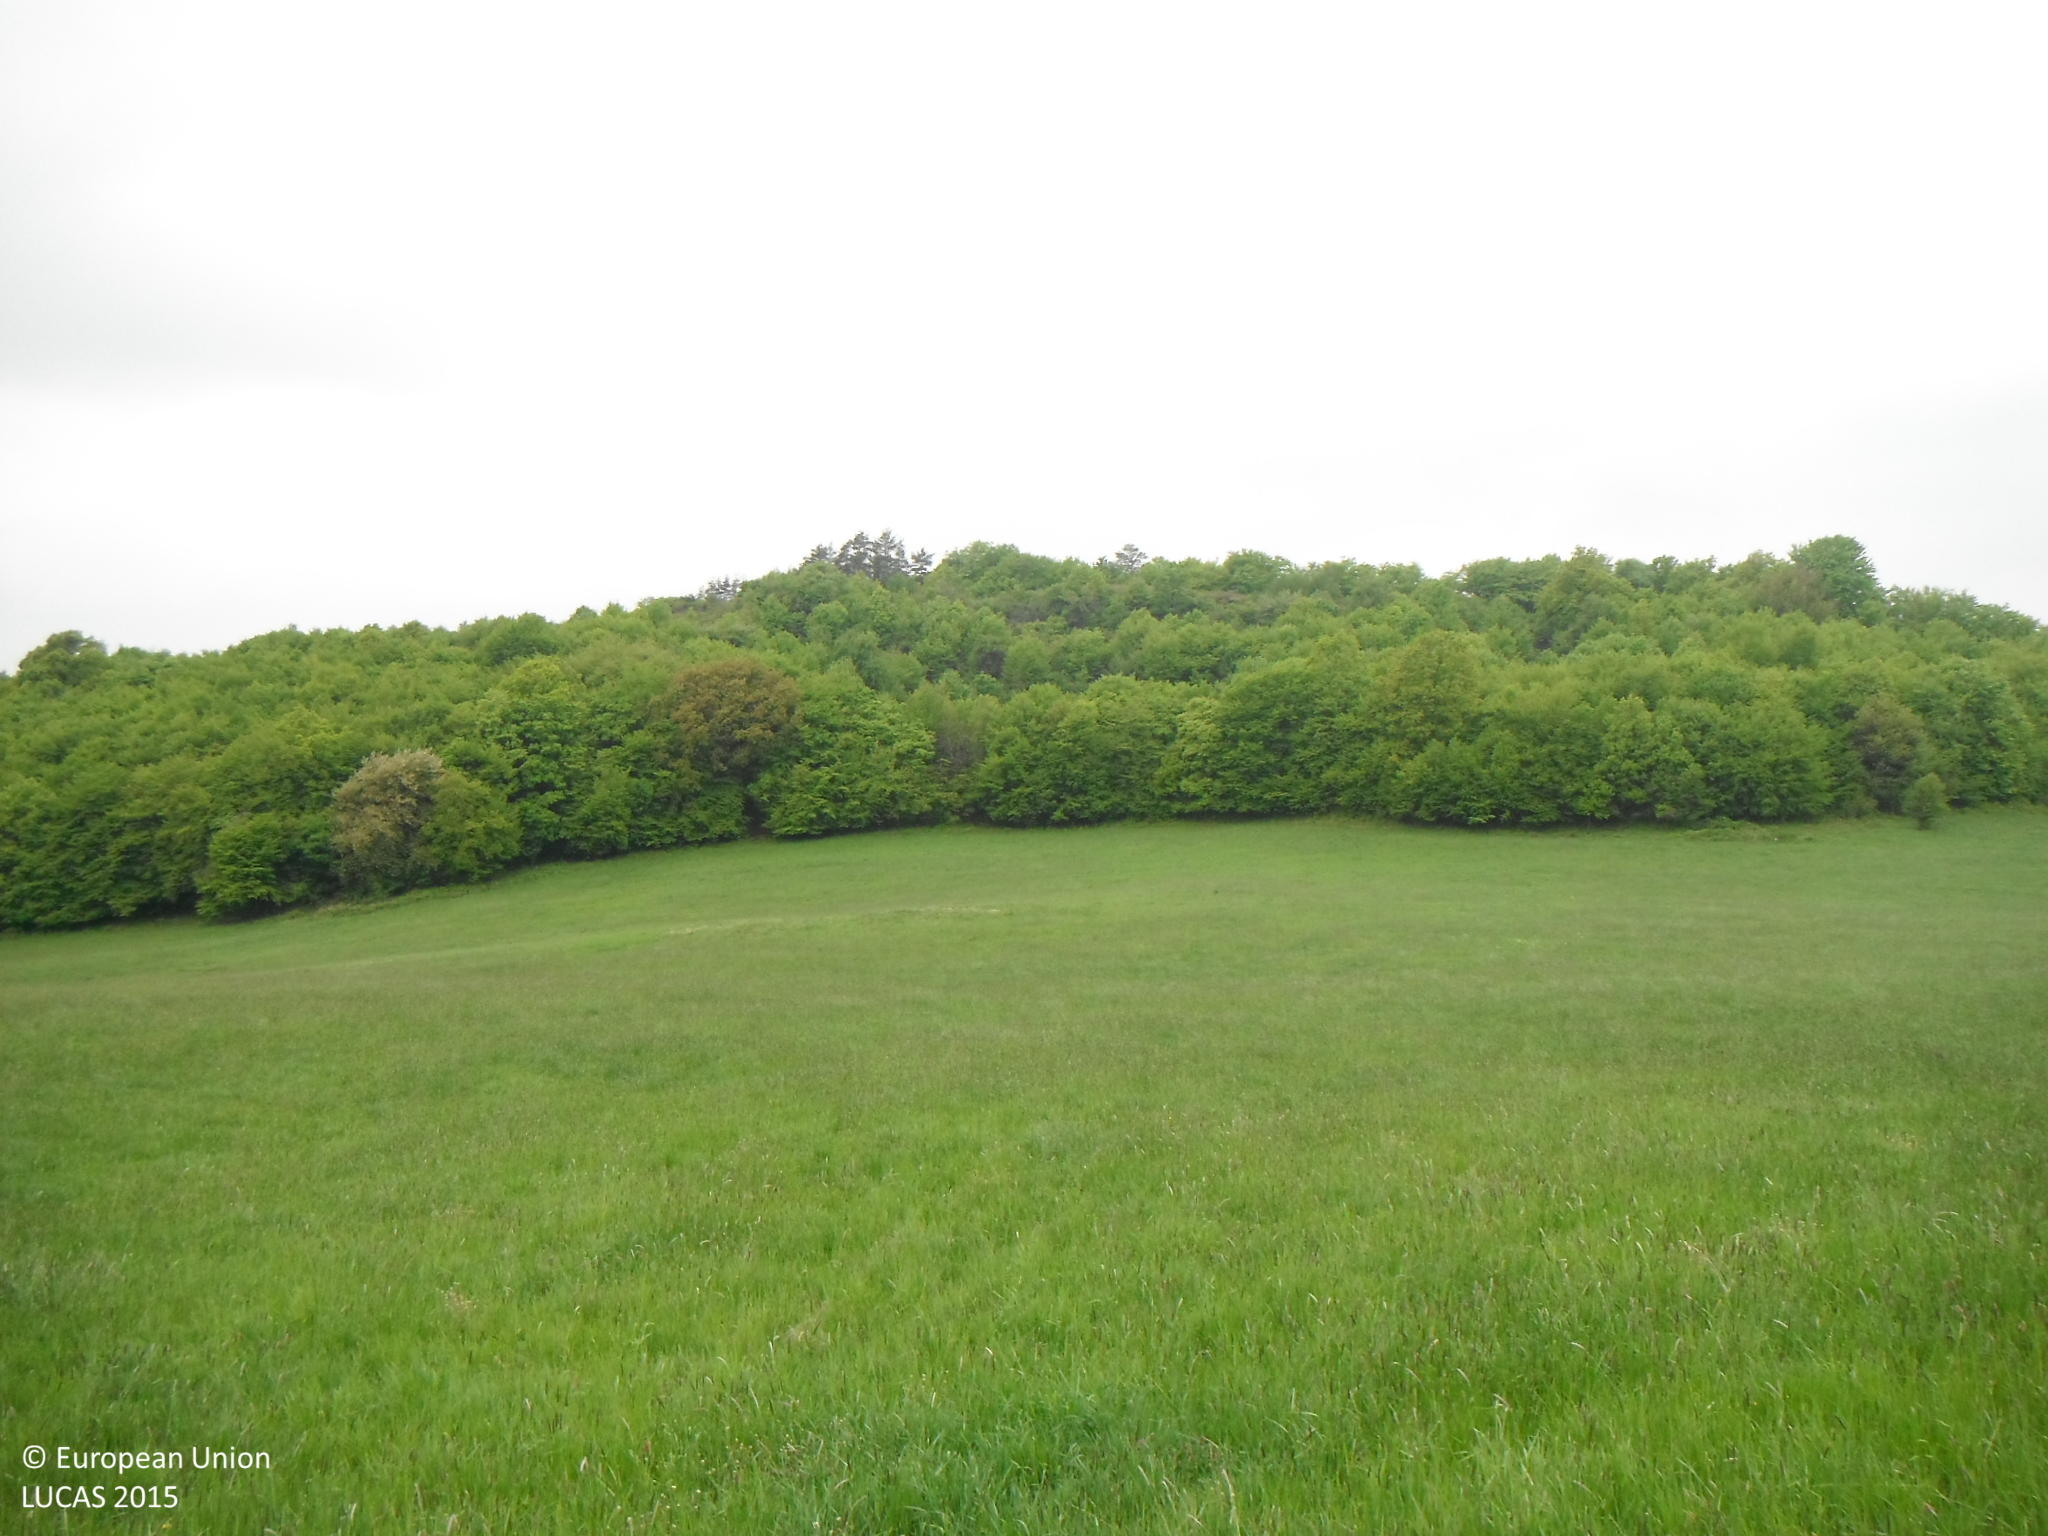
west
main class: Grassland
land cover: Grassland without tree/shrub cover
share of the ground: > 75 %
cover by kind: herbaceous plants 100 %
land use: Agriculture (excluding fallow land and kitchen gardens)
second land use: Other primary production
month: May
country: SK
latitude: 48.6005
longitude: 18.9569
